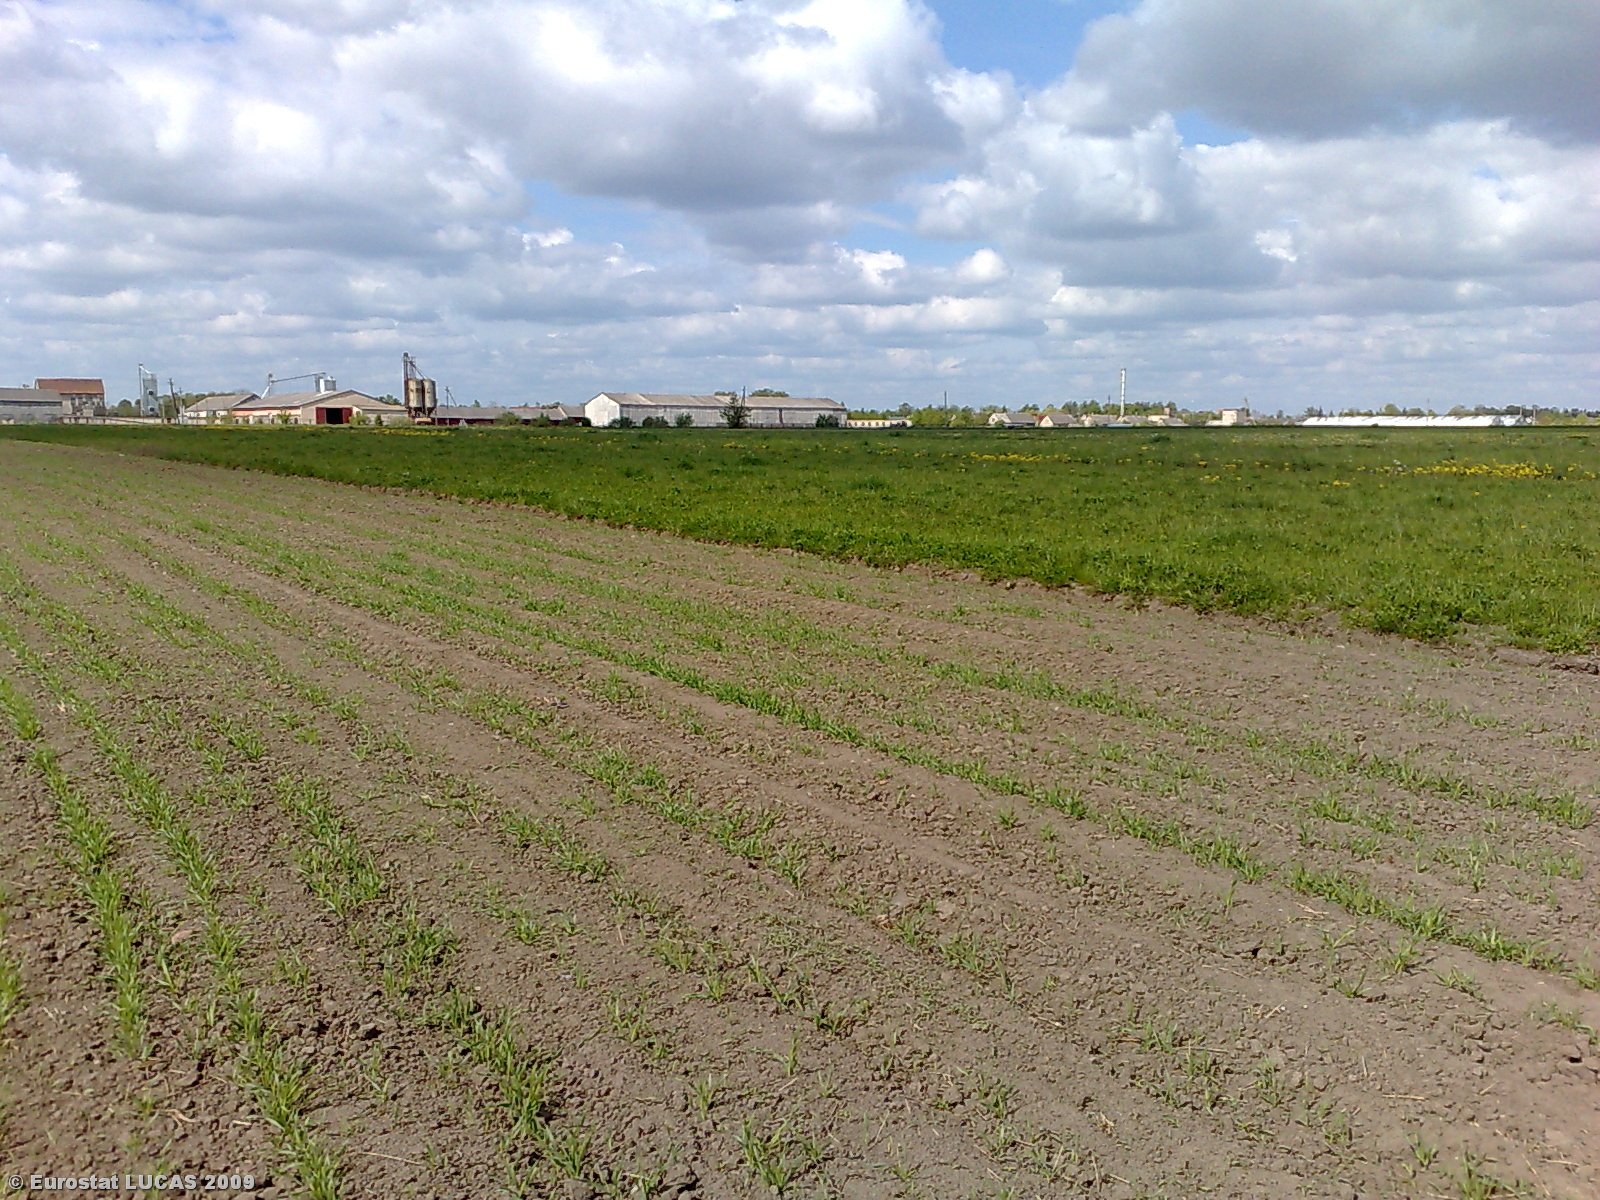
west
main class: Cropland
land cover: Barley
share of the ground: 25 - 50 %
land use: Agriculture (excluding fallow land and kitchen gardens)
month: May
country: LT
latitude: 55.6953
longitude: 23.9446
